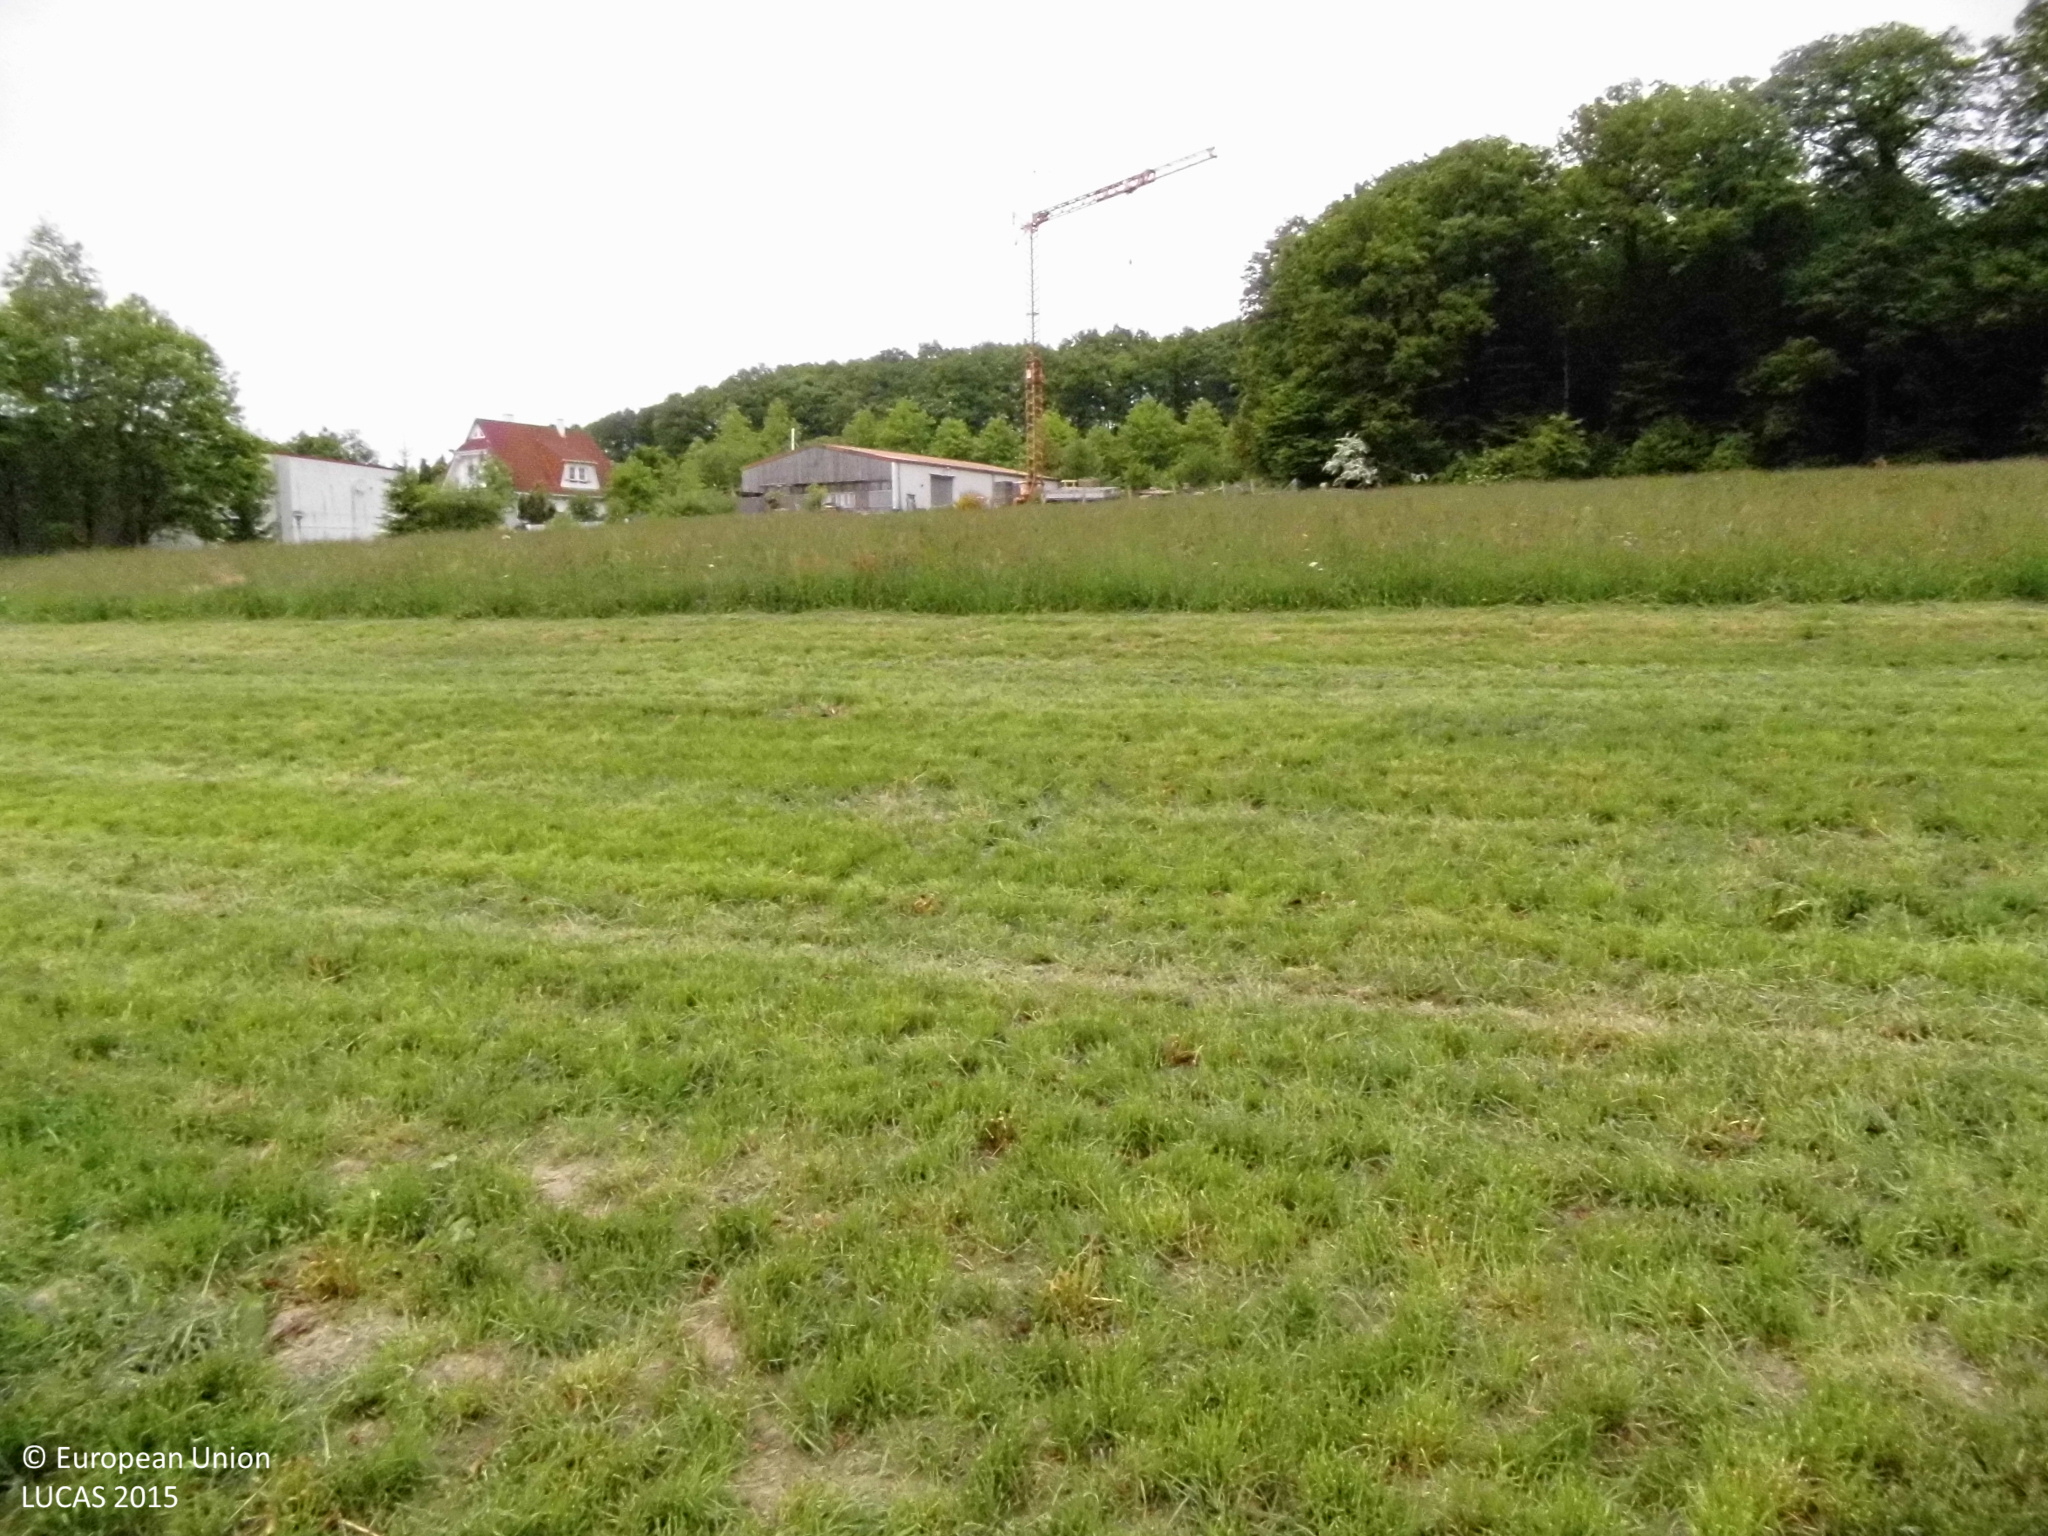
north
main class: Grassland
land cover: Grassland without tree/shrub cover
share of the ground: > 75 %
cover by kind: herbaceous plants 100 %
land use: Agriculture (excluding fallow land and kitchen gardens)
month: May
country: DE
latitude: 50.5341
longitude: 7.4748
